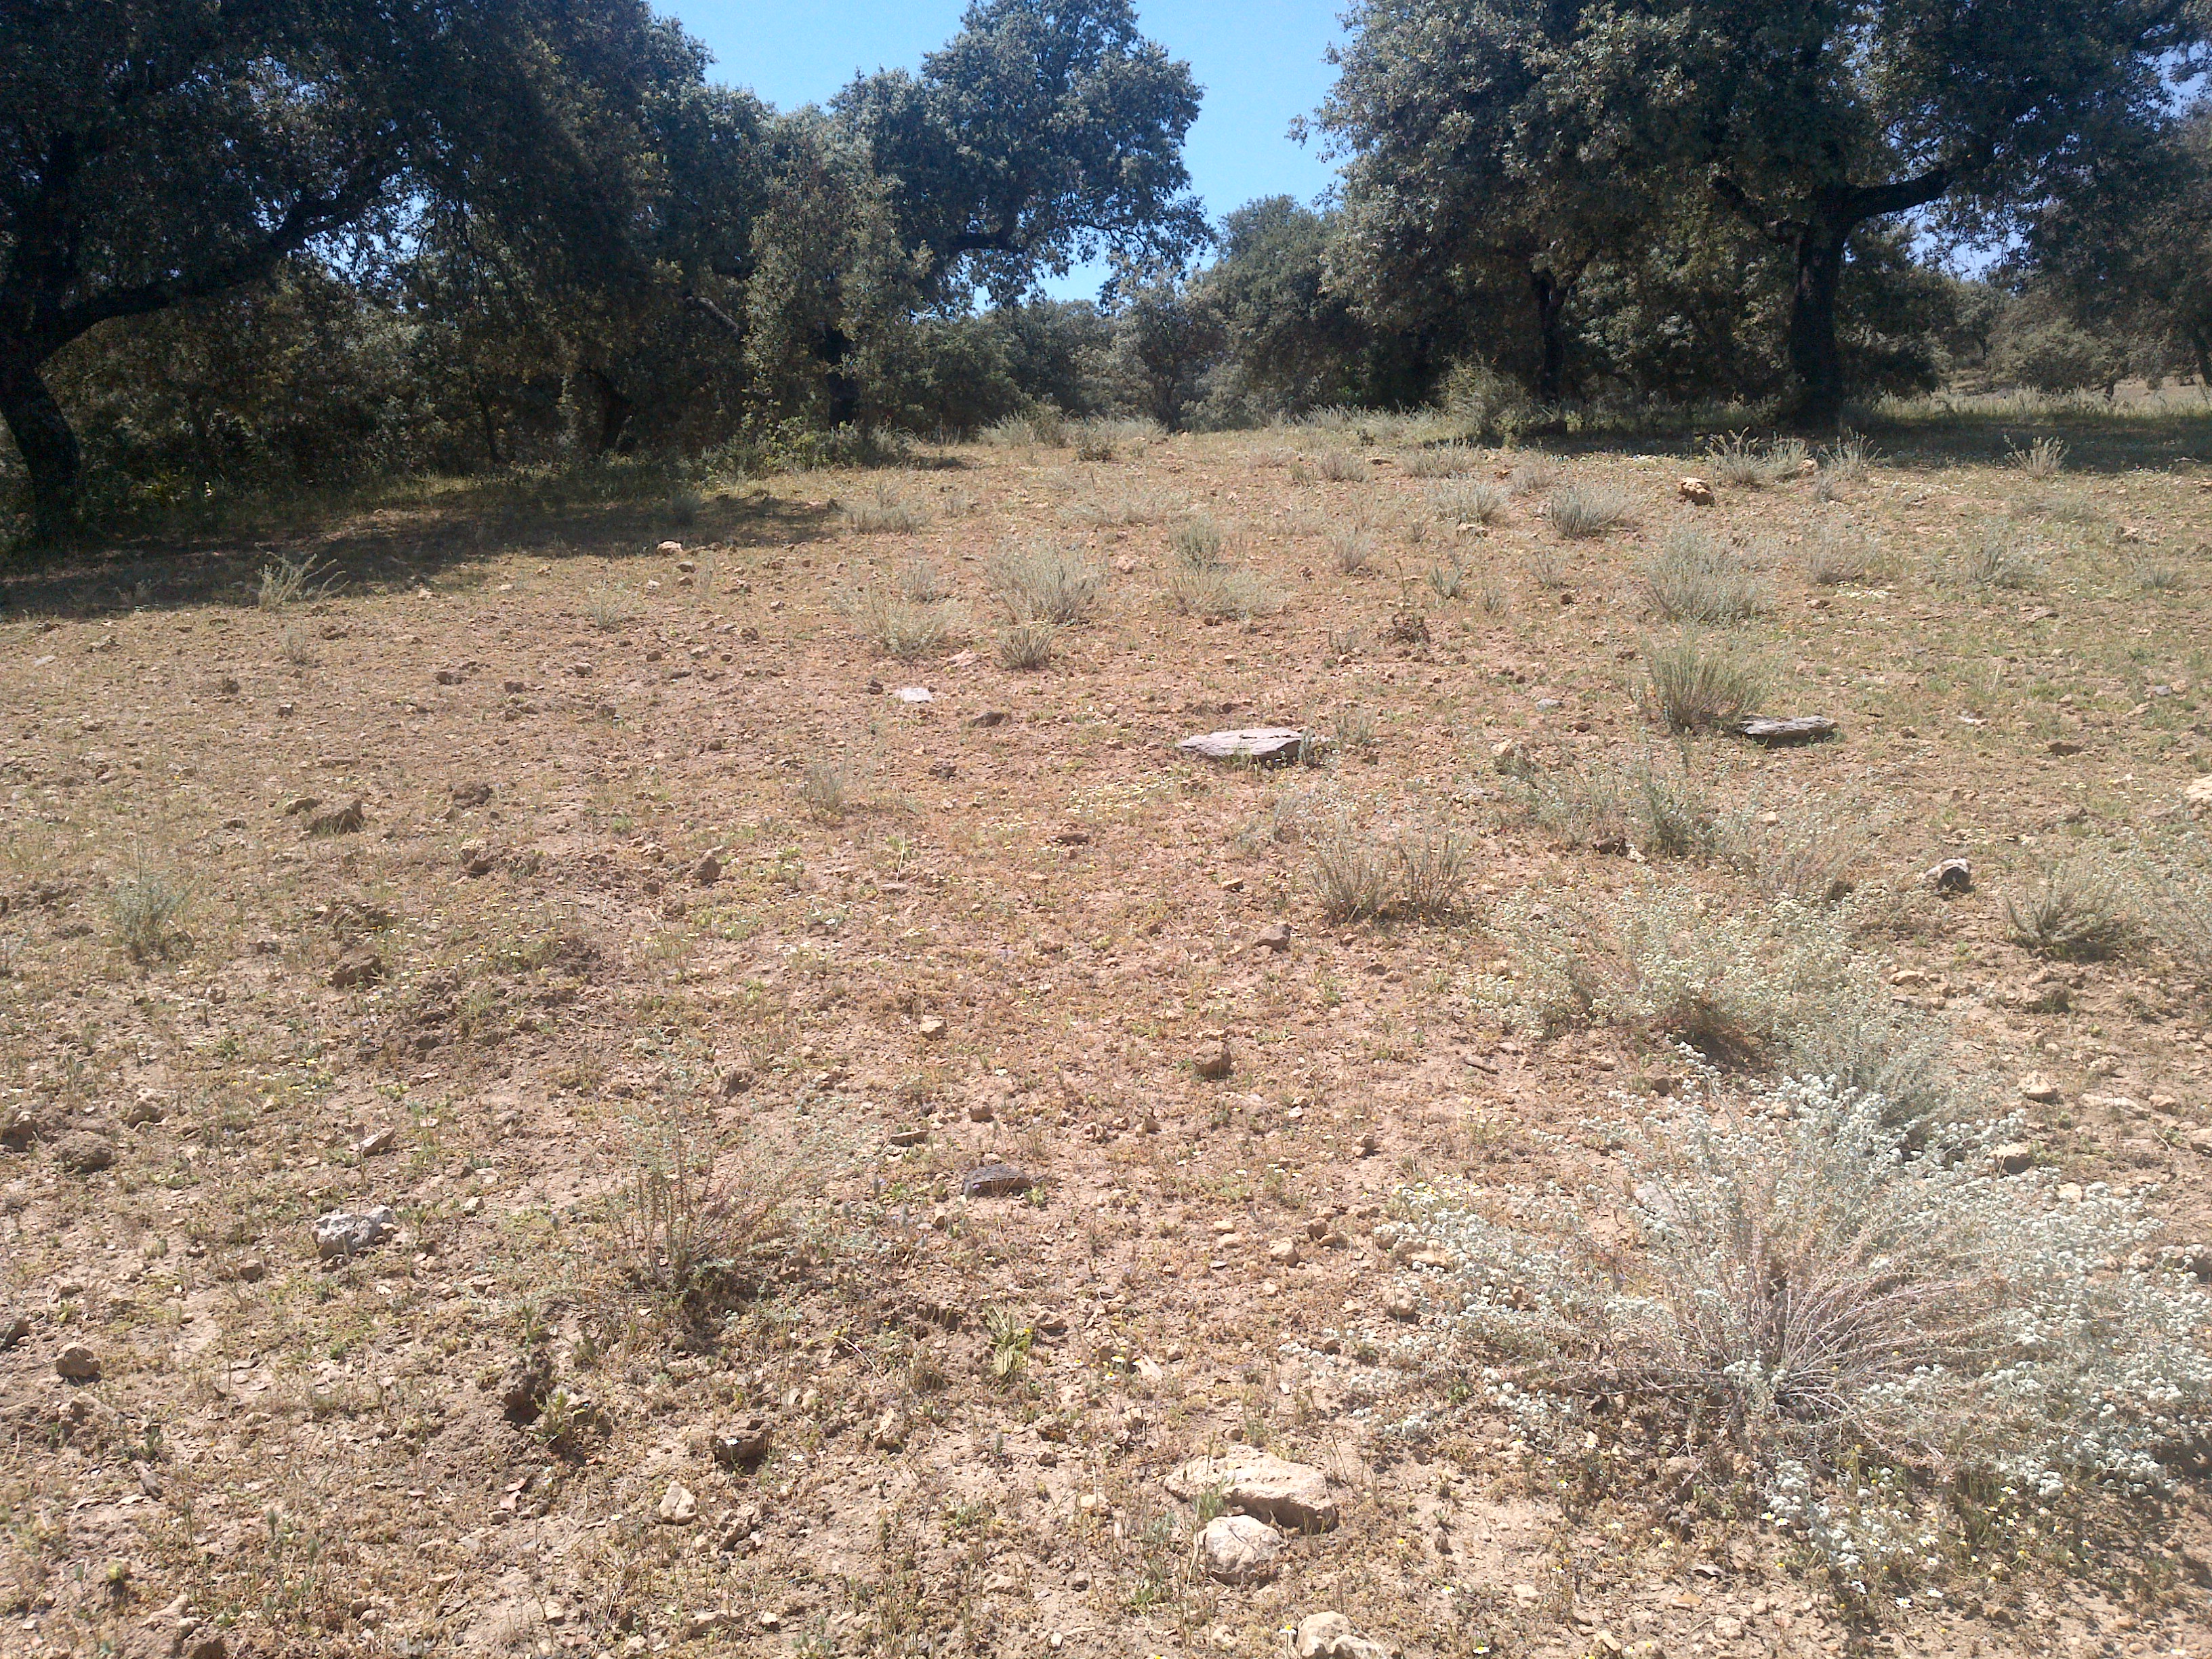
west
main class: Woodland
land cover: Broadleaved woodland
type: broadleaved evergreen forest
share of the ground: 10 - 25 %
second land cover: Spontaneously vegetated surfaces
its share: > 75 %
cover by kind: herbaceous plants 85 %, broadleaved forest trees 15 %
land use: Forestry
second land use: Agriculture (excluding fallow land and kitchen gardens)
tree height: > 5 m
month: May
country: ES
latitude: 37.8982
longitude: -4.9718
